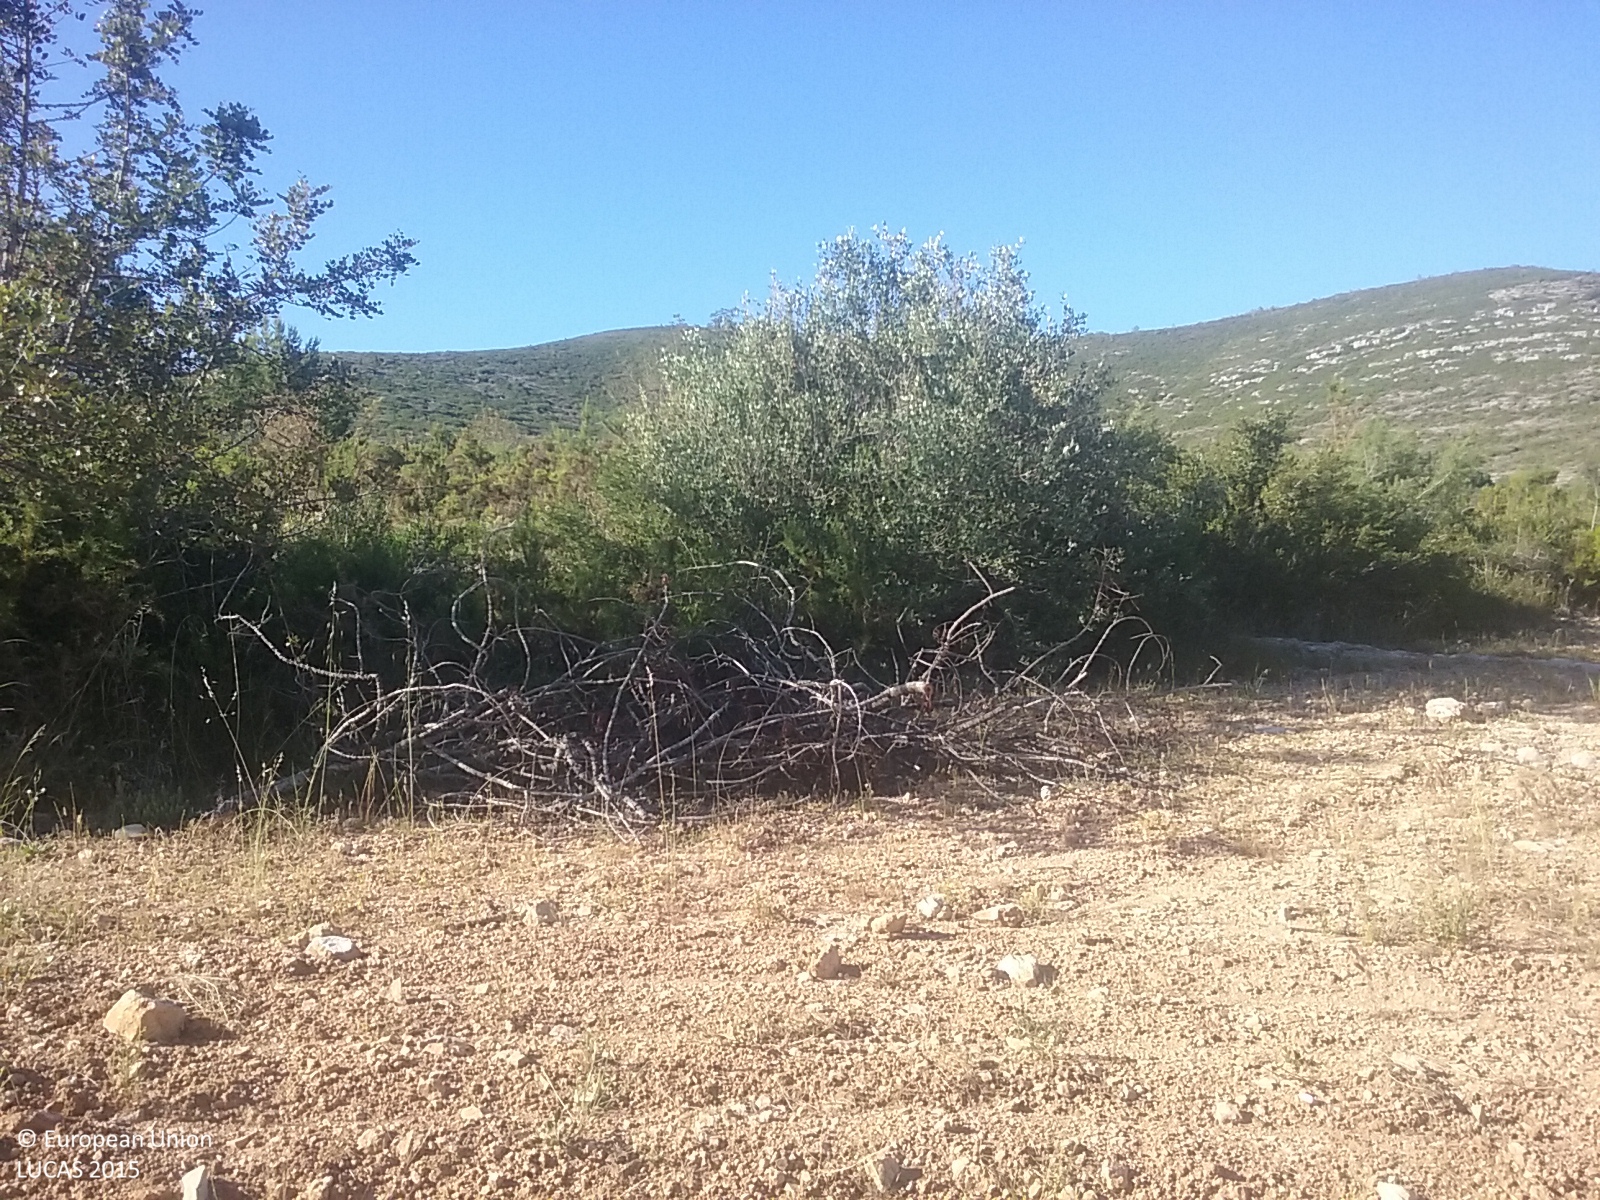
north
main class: Cropland
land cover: Permanent industrial crops
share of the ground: 10 - 25 %
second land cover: Other bare soil
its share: > 75 %
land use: Agriculture (excluding fallow land and kitchen gardens)
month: May
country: ES
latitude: 40.3439
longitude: 0.2374
